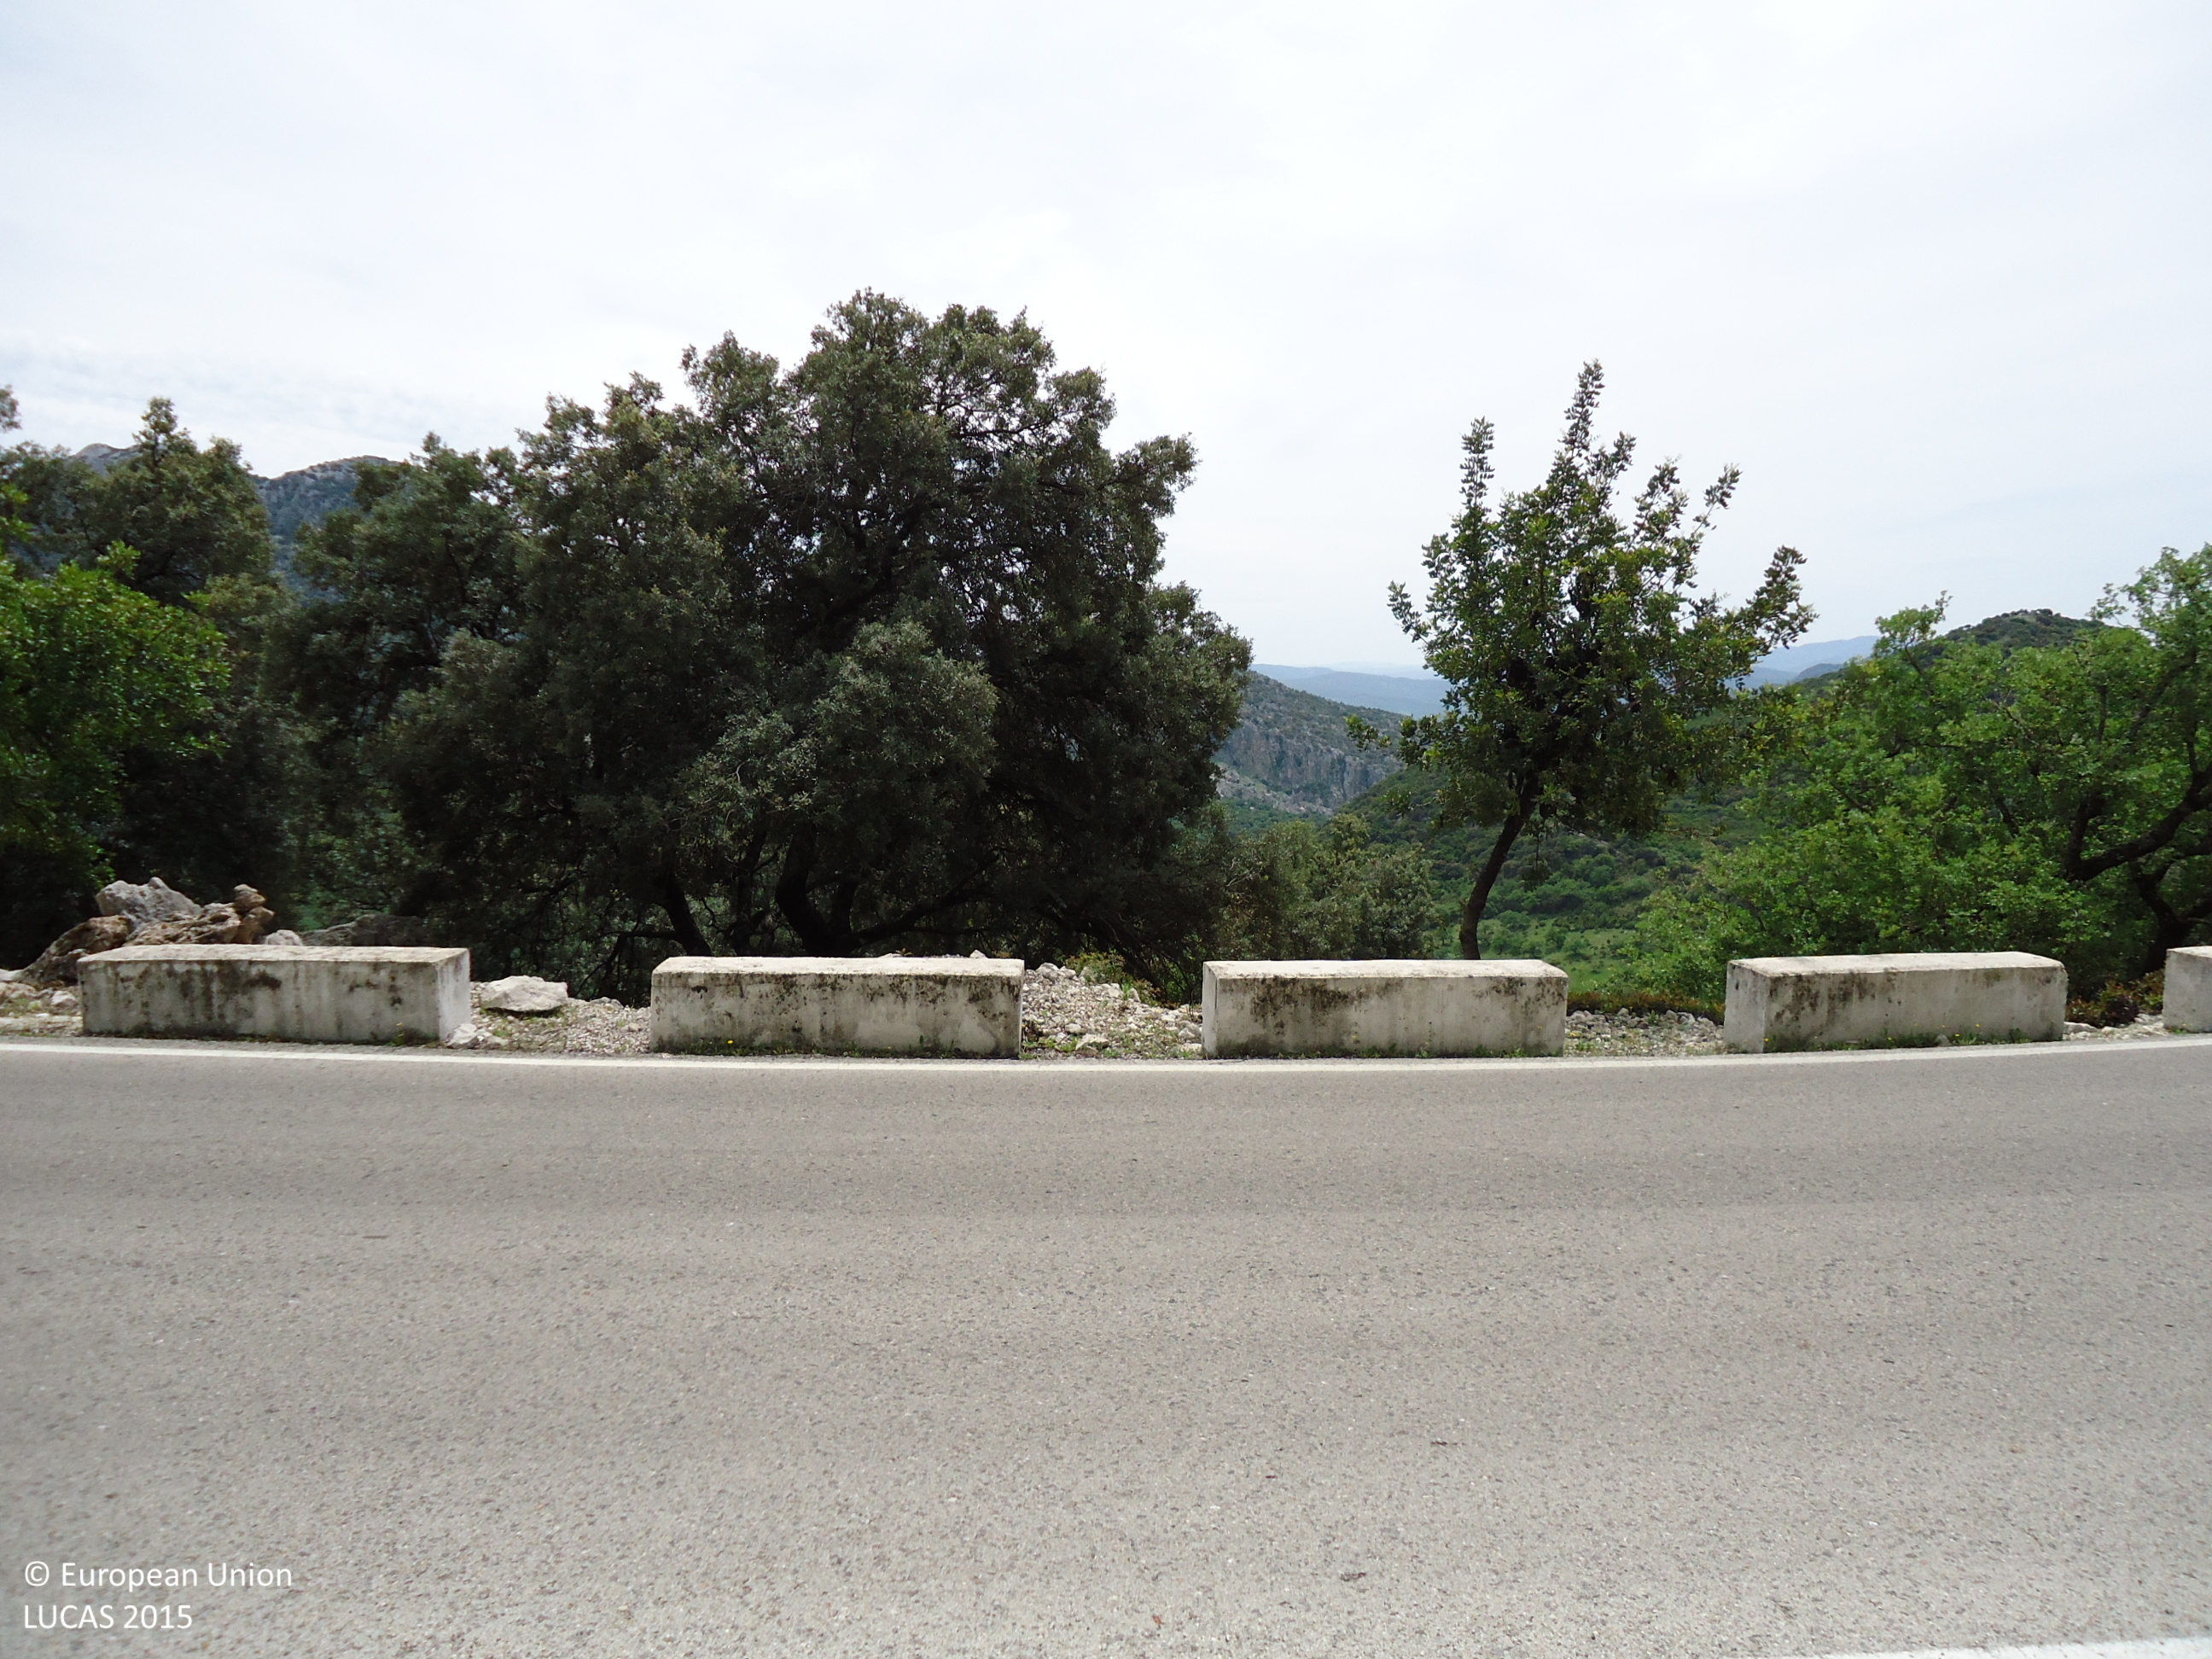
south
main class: Woodland
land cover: Broadleaved woodland
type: broadleaved evergreen forest
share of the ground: > 75 %
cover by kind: broadleaved forest trees 80 %, shrubs 10 %, coniferous forest trees 5 %, herbaceous plants 5 %
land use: Semi-natural and natural areas not in use
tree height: > 5 m
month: May
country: ES
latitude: 36.7567
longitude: -5.4274
